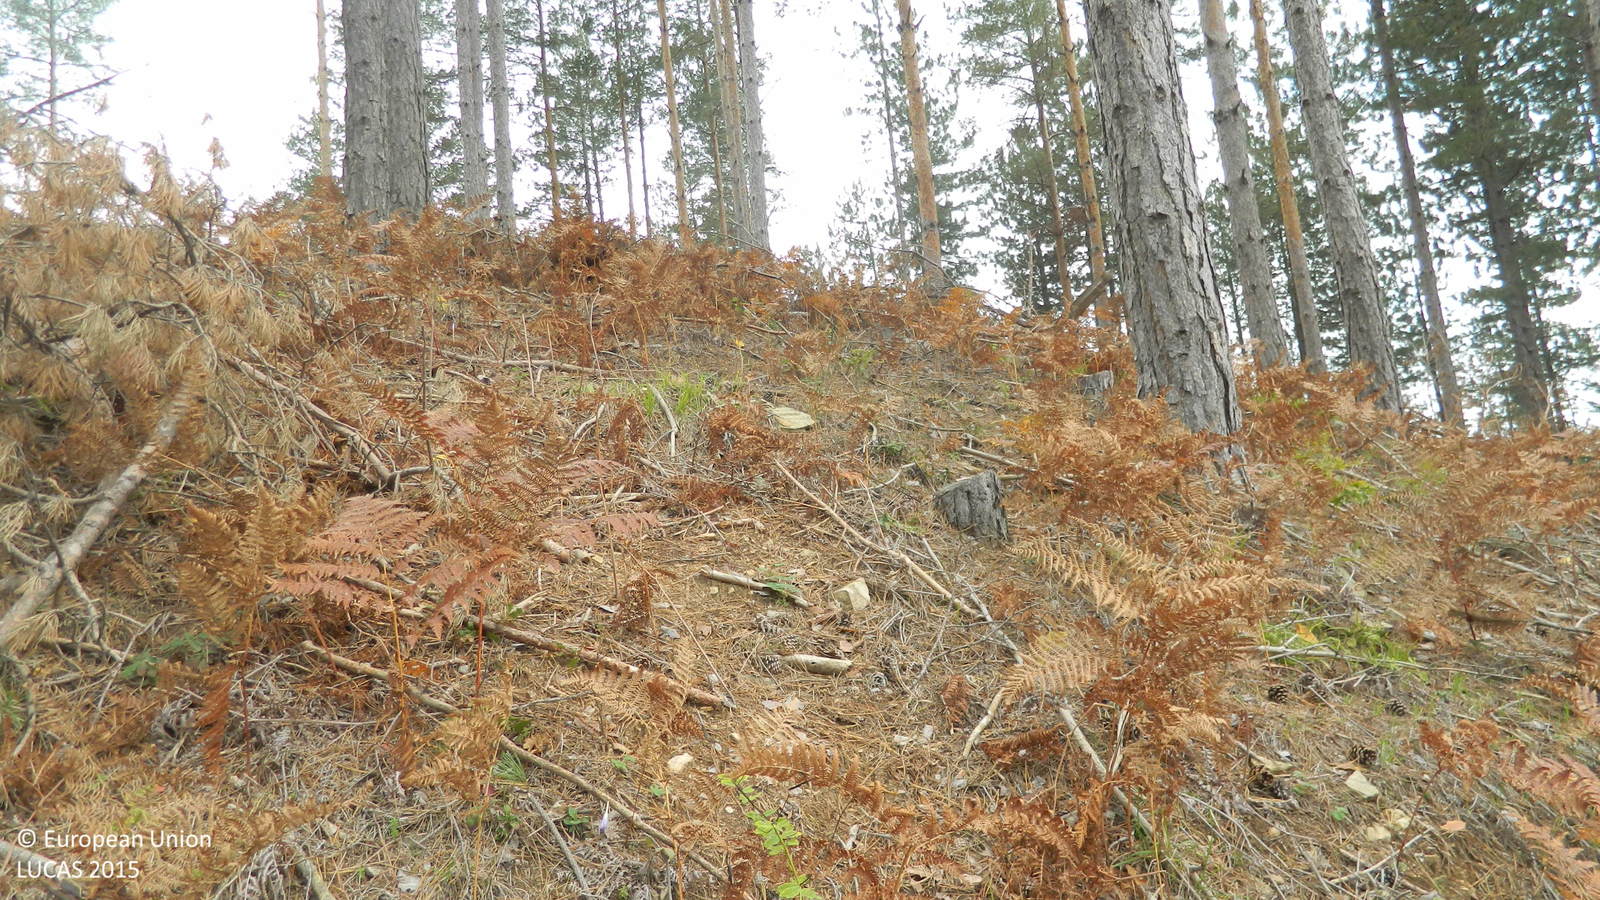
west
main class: Woodland
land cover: Pine dominated coniferous woodland
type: hemiboreal forest and nemoral coniferous forest and mixed broadleaved-coniferous forest
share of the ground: > 75 %
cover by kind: coniferous forest trees 90 %, broadleaved forest trees 5 %, herbaceous plants 5 %
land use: Forestry
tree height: > 5 m
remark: Clear cut
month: November
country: BG
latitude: 41.2998
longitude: 25.3020
